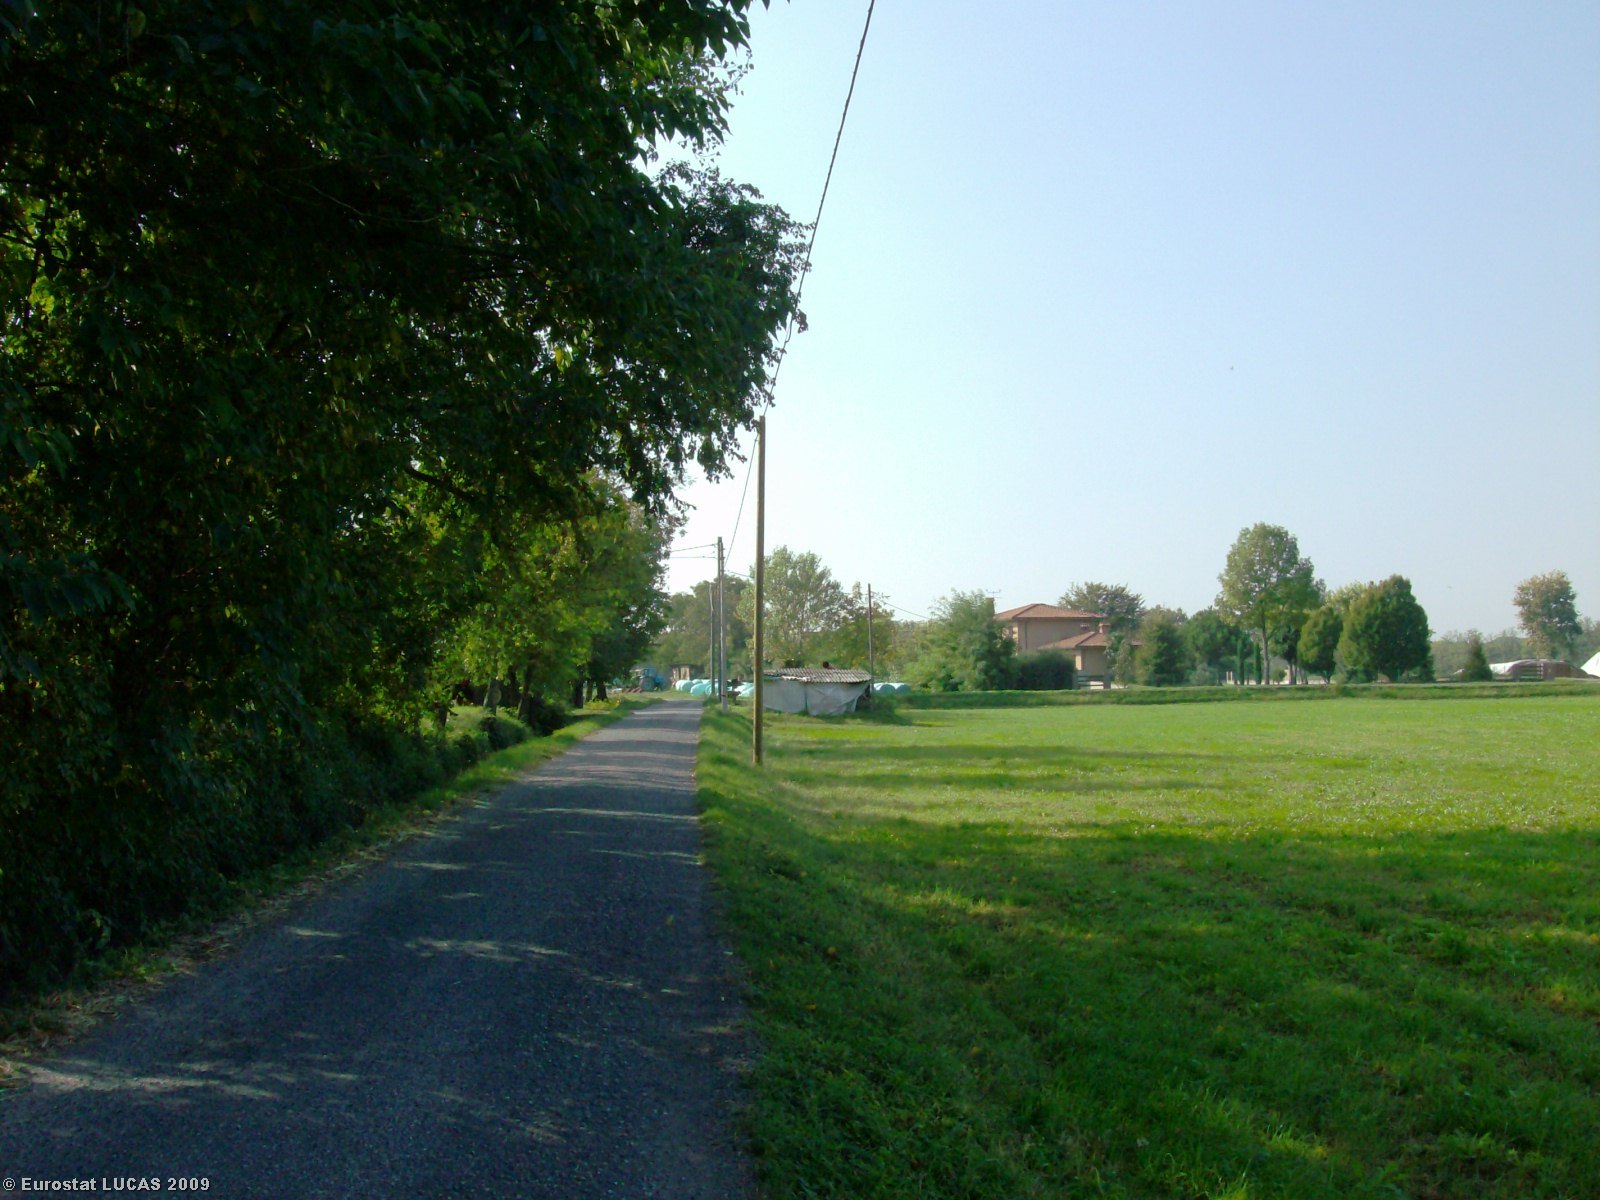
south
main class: Grassland
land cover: Grassland without tree/shrub cover
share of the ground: > 75 %
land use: Agriculture (excluding fallow land and kitchen gardens)
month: September
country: IT
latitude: 45.5033
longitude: 9.5273
